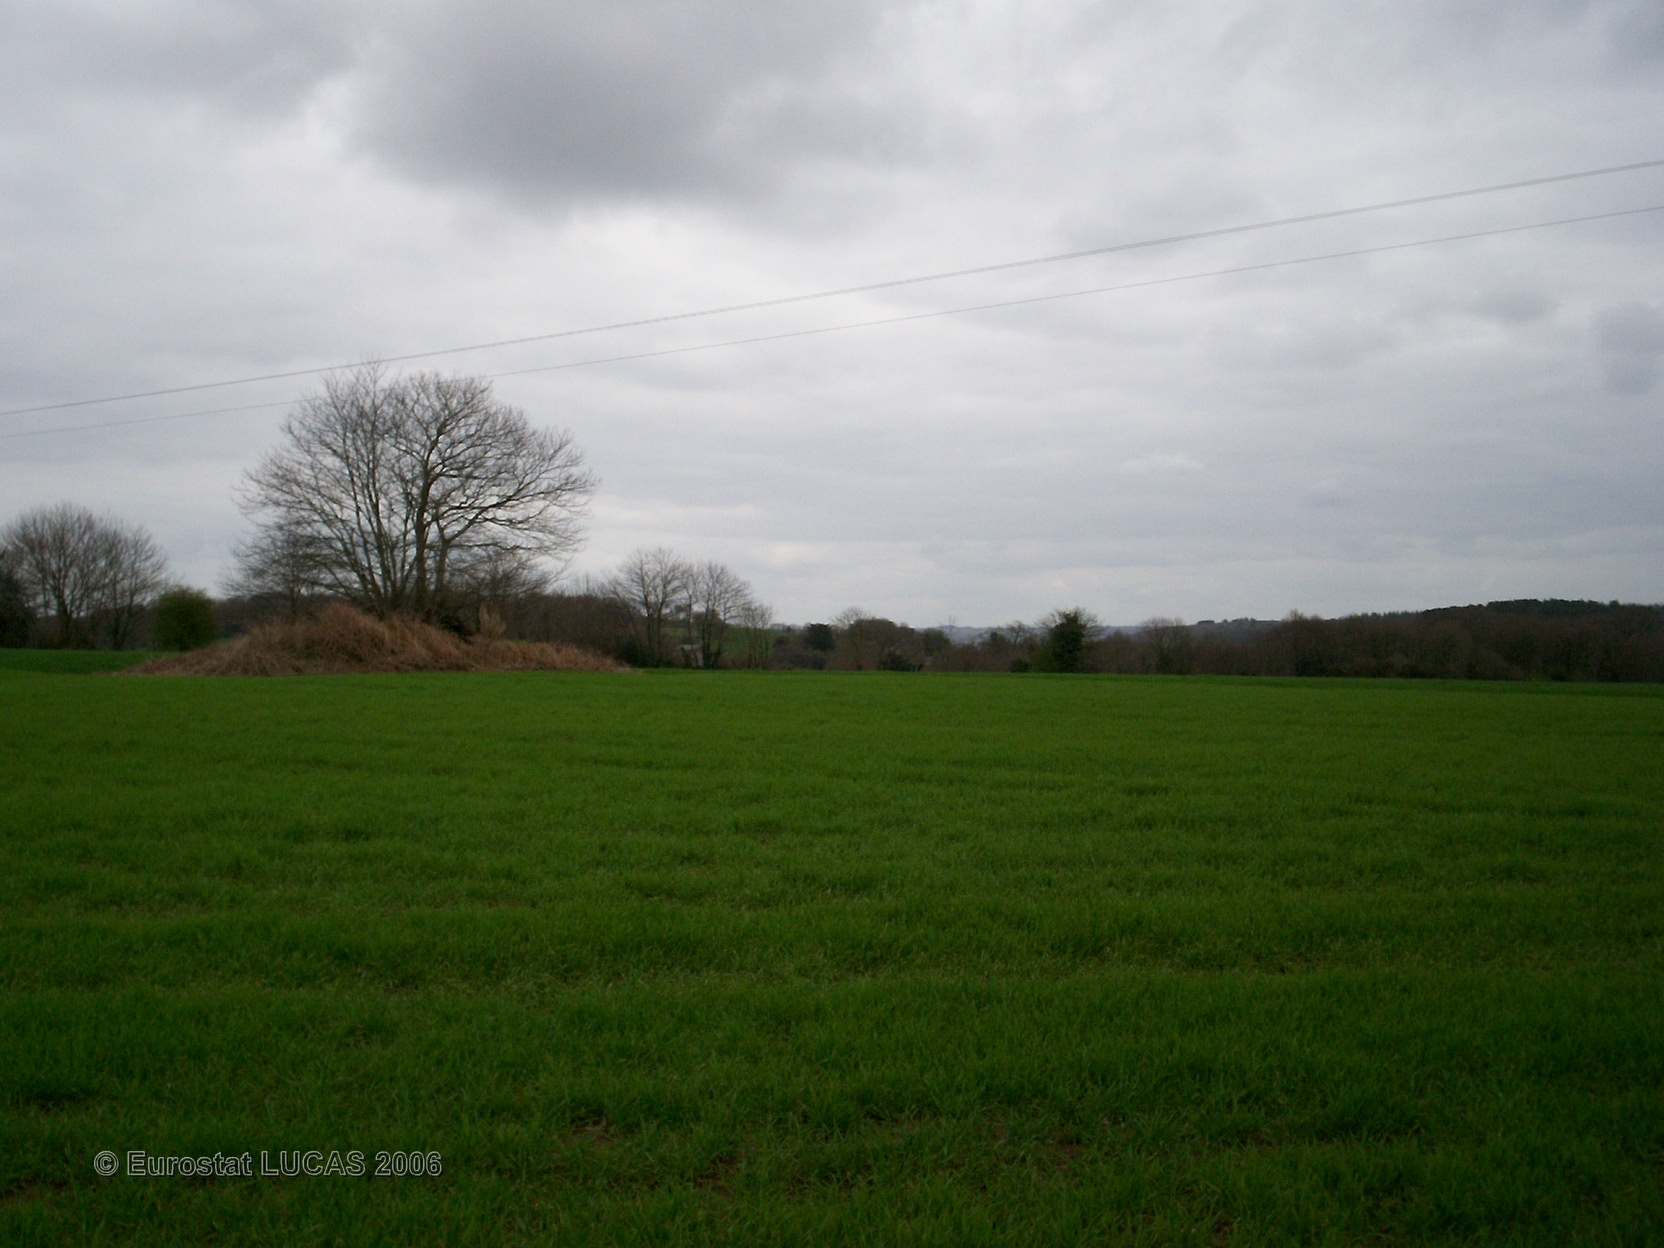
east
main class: Cropland
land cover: Common wheat
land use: Agriculture (excluding fallow land and kitchen gardens)
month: April
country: FR
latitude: 47.9818
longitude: -3.5695
